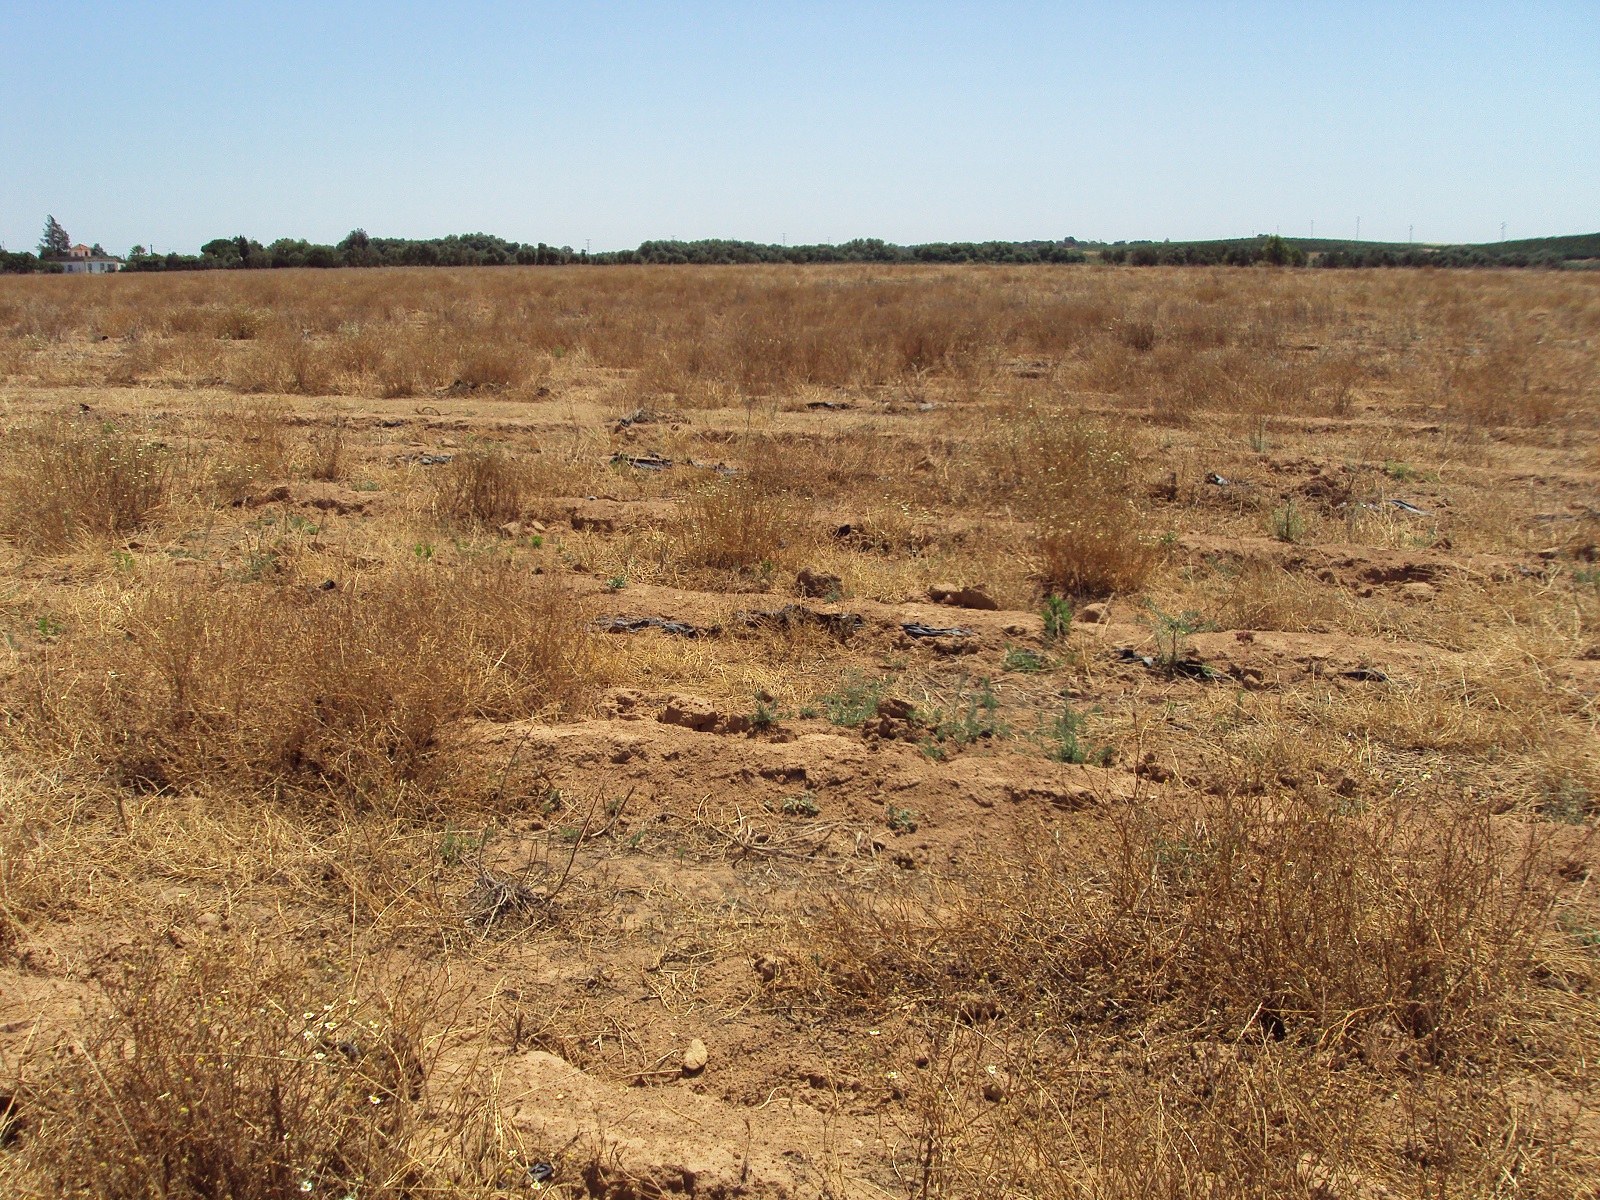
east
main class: Grassland
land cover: Grassland without tree/shrub cover
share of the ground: > 75 %
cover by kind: herbaceous plants 90 %, unconsolidated bare surface 10 %
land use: Agriculture (excluding fallow land and kitchen gardens)
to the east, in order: Grassland without tree/shrub cover; Sunflower
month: June
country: ES
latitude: 37.3647
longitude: -6.9202
